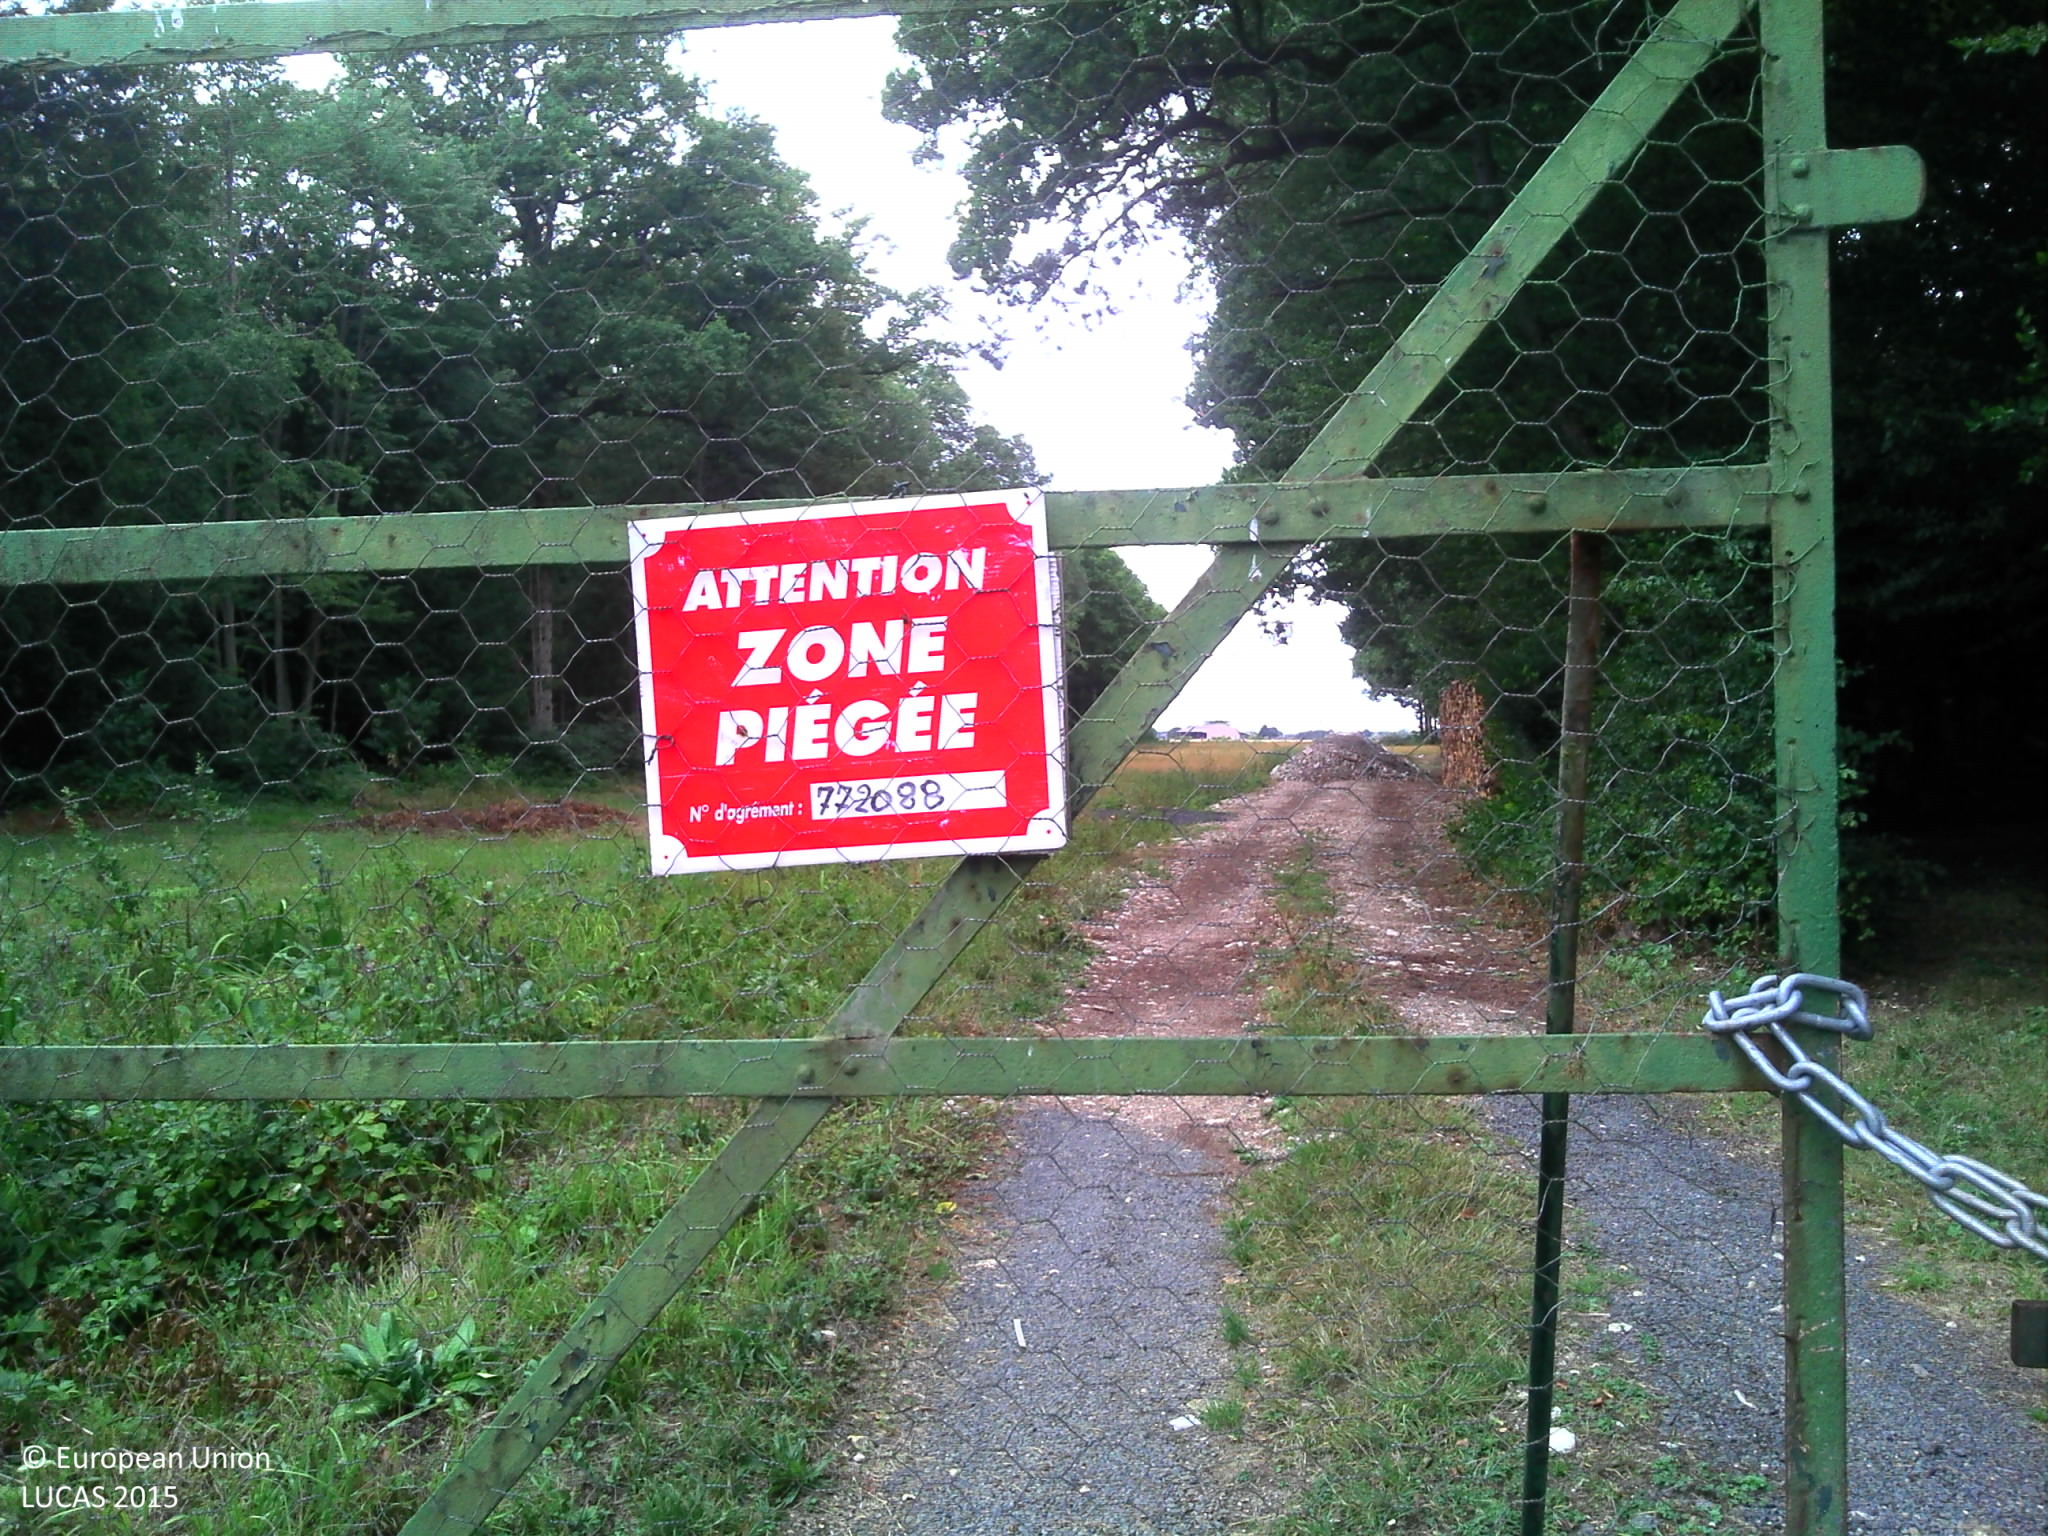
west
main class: Woodland
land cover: Broadleaved woodland
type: acidophilous oak and oak-birch forest
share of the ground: > 75 %
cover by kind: broadleaved forest trees 100 %
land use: Forestry
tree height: > 5 m
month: July
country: FR
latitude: 48.7214
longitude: 2.6905
